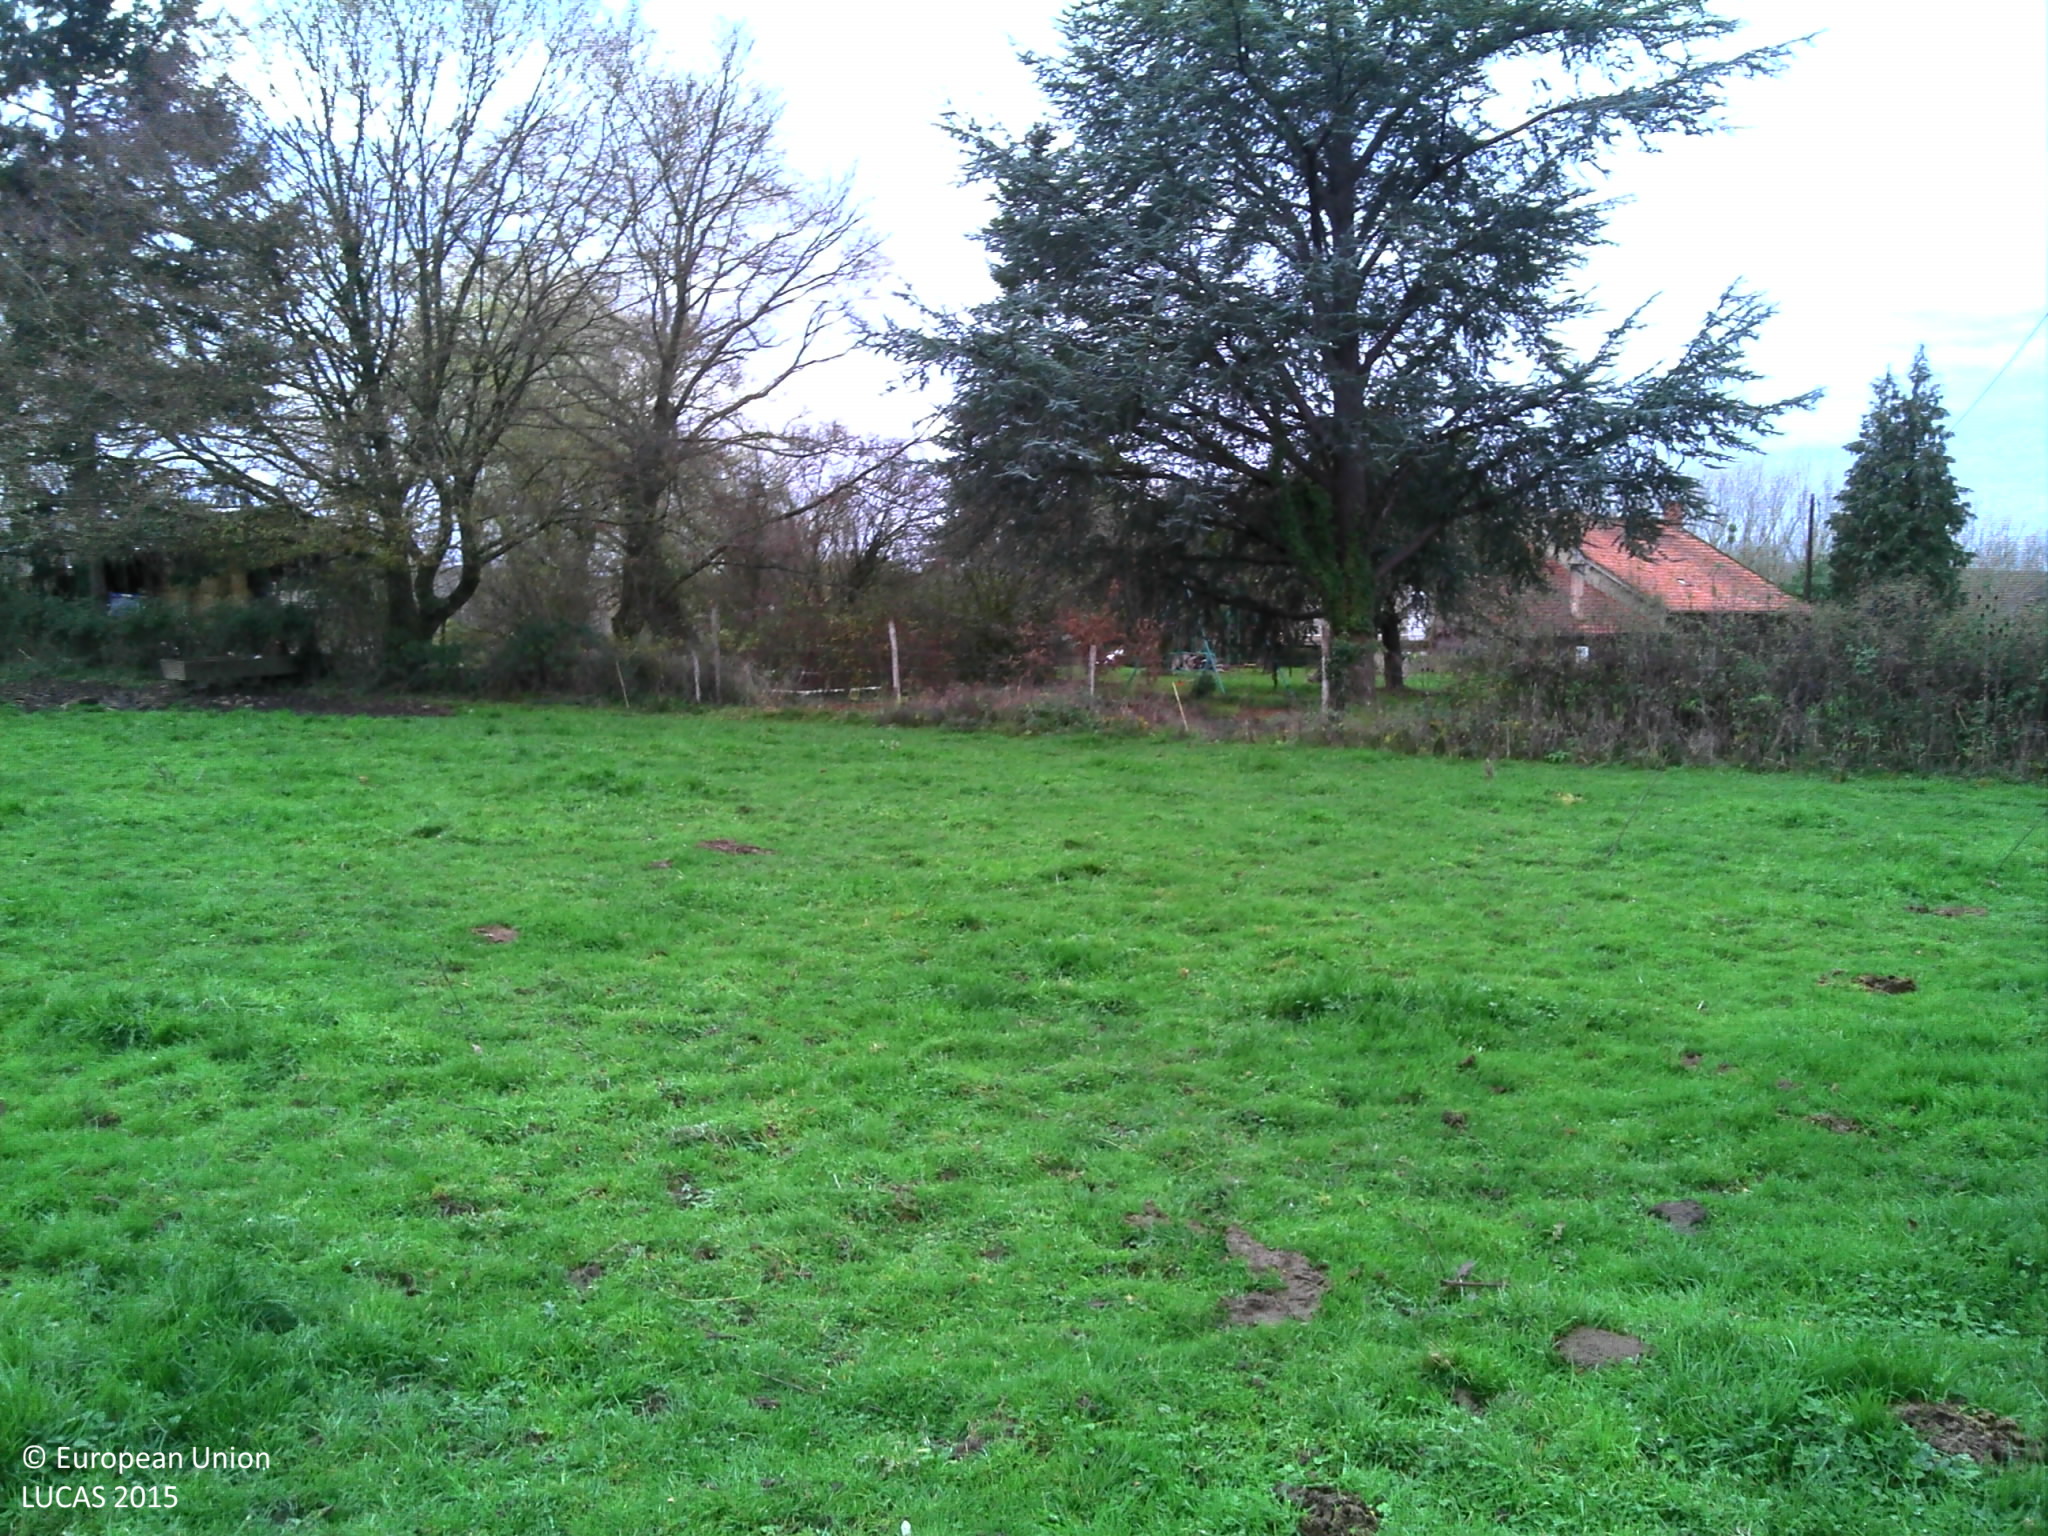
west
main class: Grassland
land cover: Grassland without tree/shrub cover
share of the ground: > 75 %
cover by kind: herbaceous plants 100 %
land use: Agriculture (excluding fallow land and kitchen gardens)
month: November
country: FR
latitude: 46.6418
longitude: 3.2172
